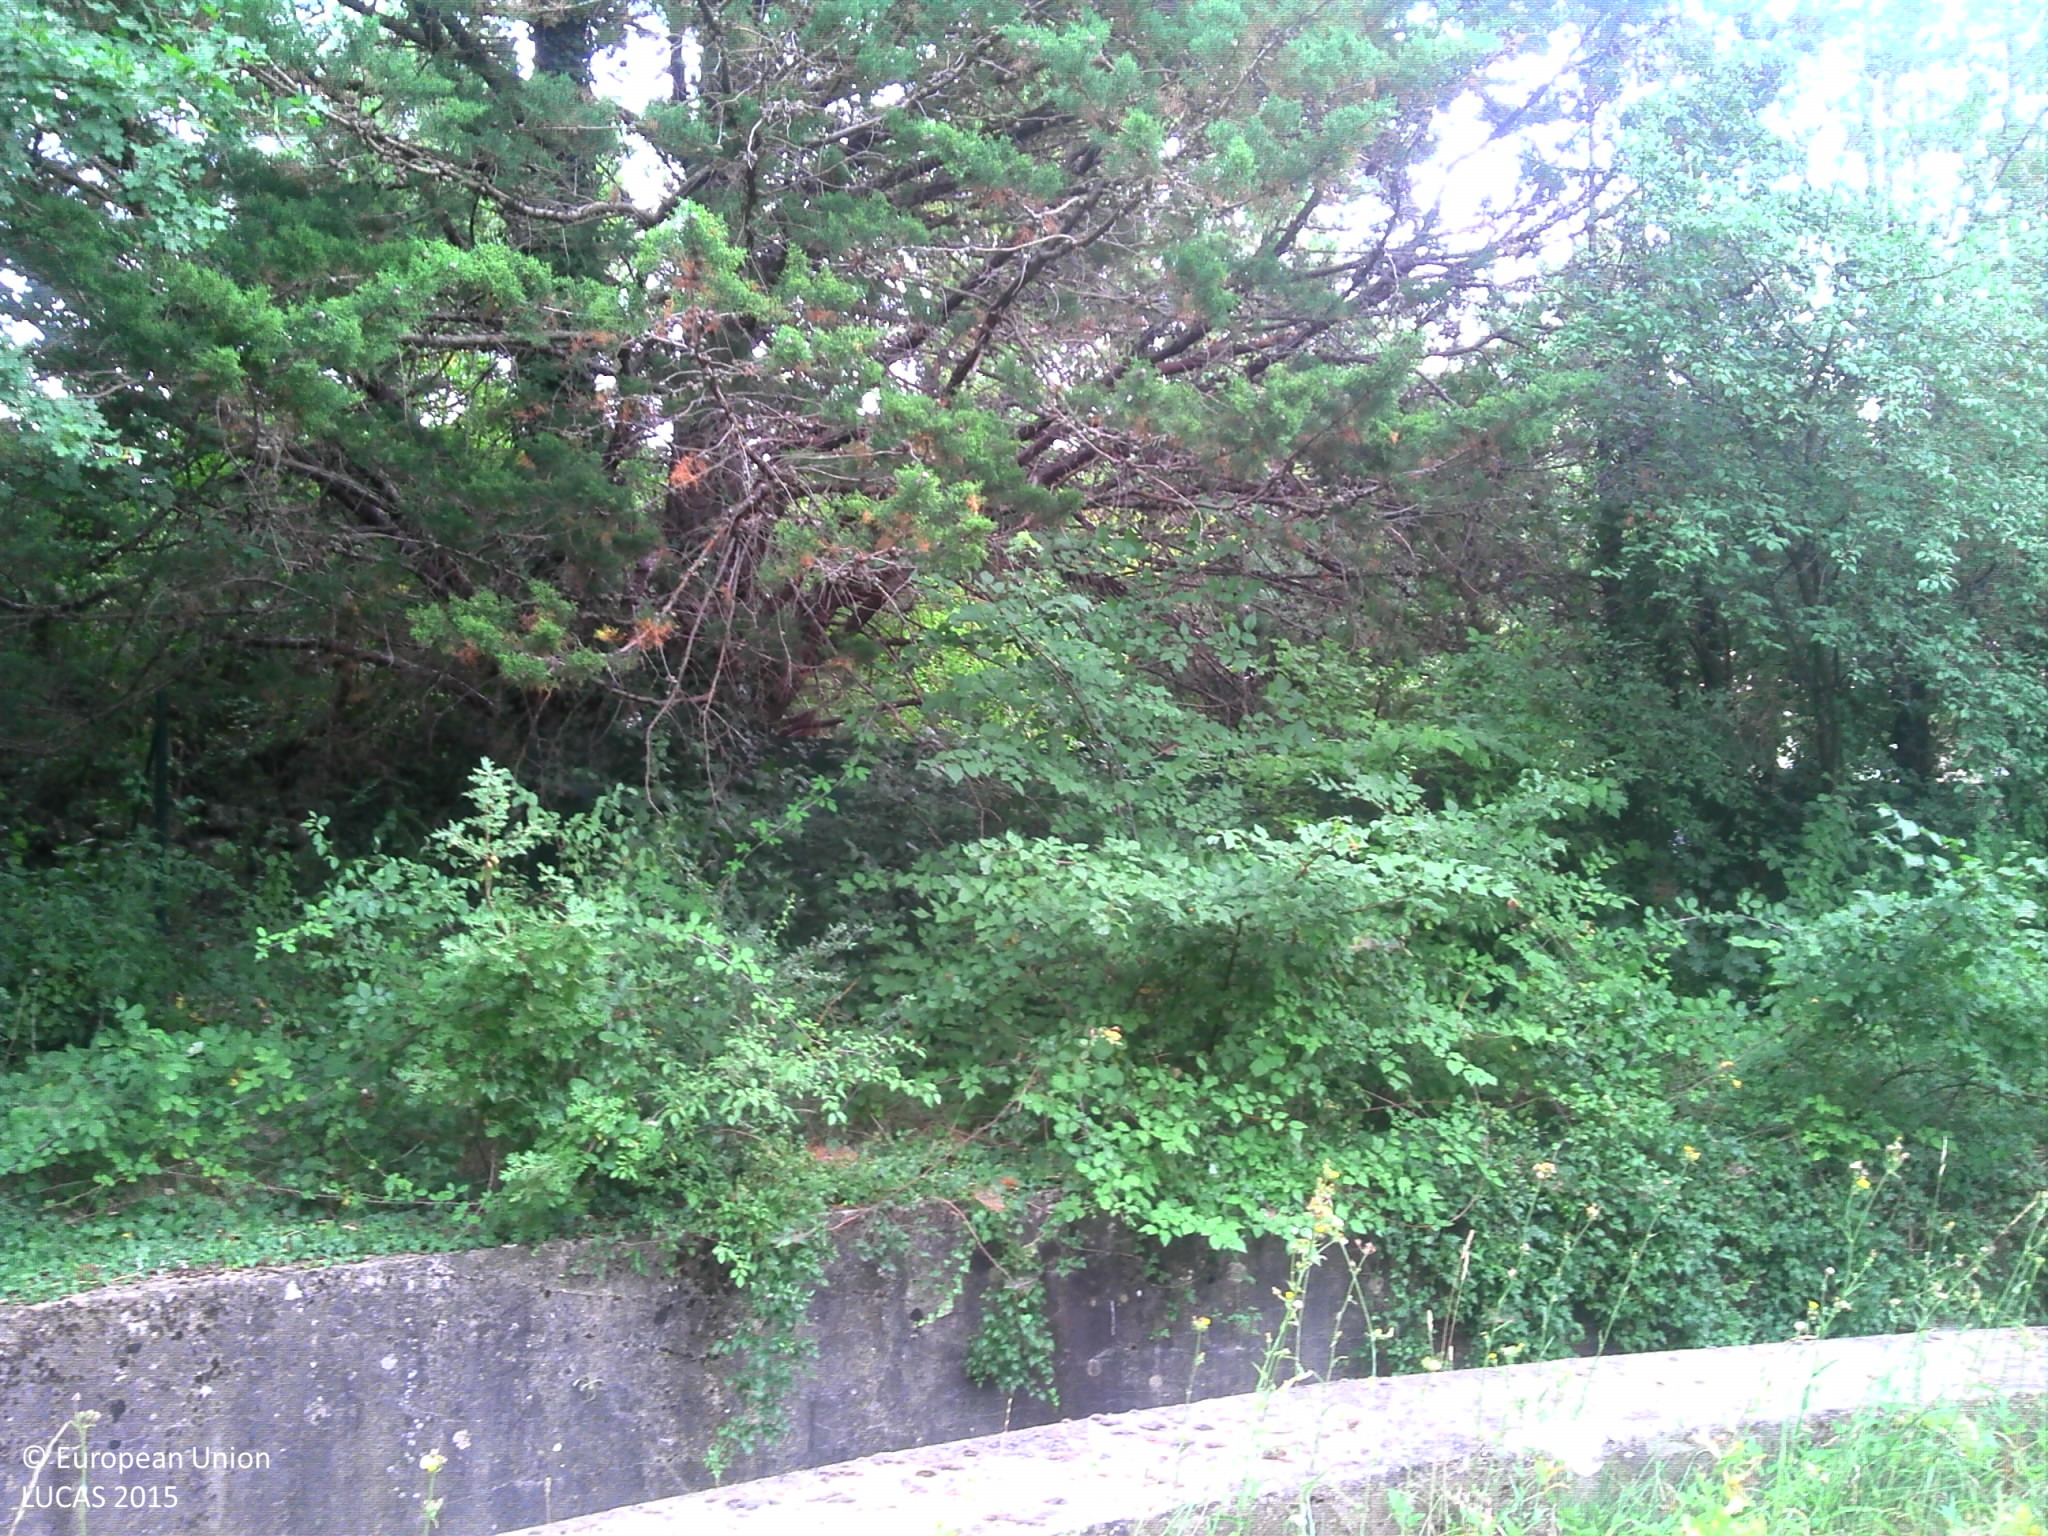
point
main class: Woodland
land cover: Pine dominated mixed woodland
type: mesophytic deciduous forest
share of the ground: > 75 %
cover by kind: coniferous forest trees 45 %, broadleaved forest trees 35 %, herbaceous plants 20 %
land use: Forestry
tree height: < 5 m
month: October
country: FR
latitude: 43.4601
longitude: 5.5480
